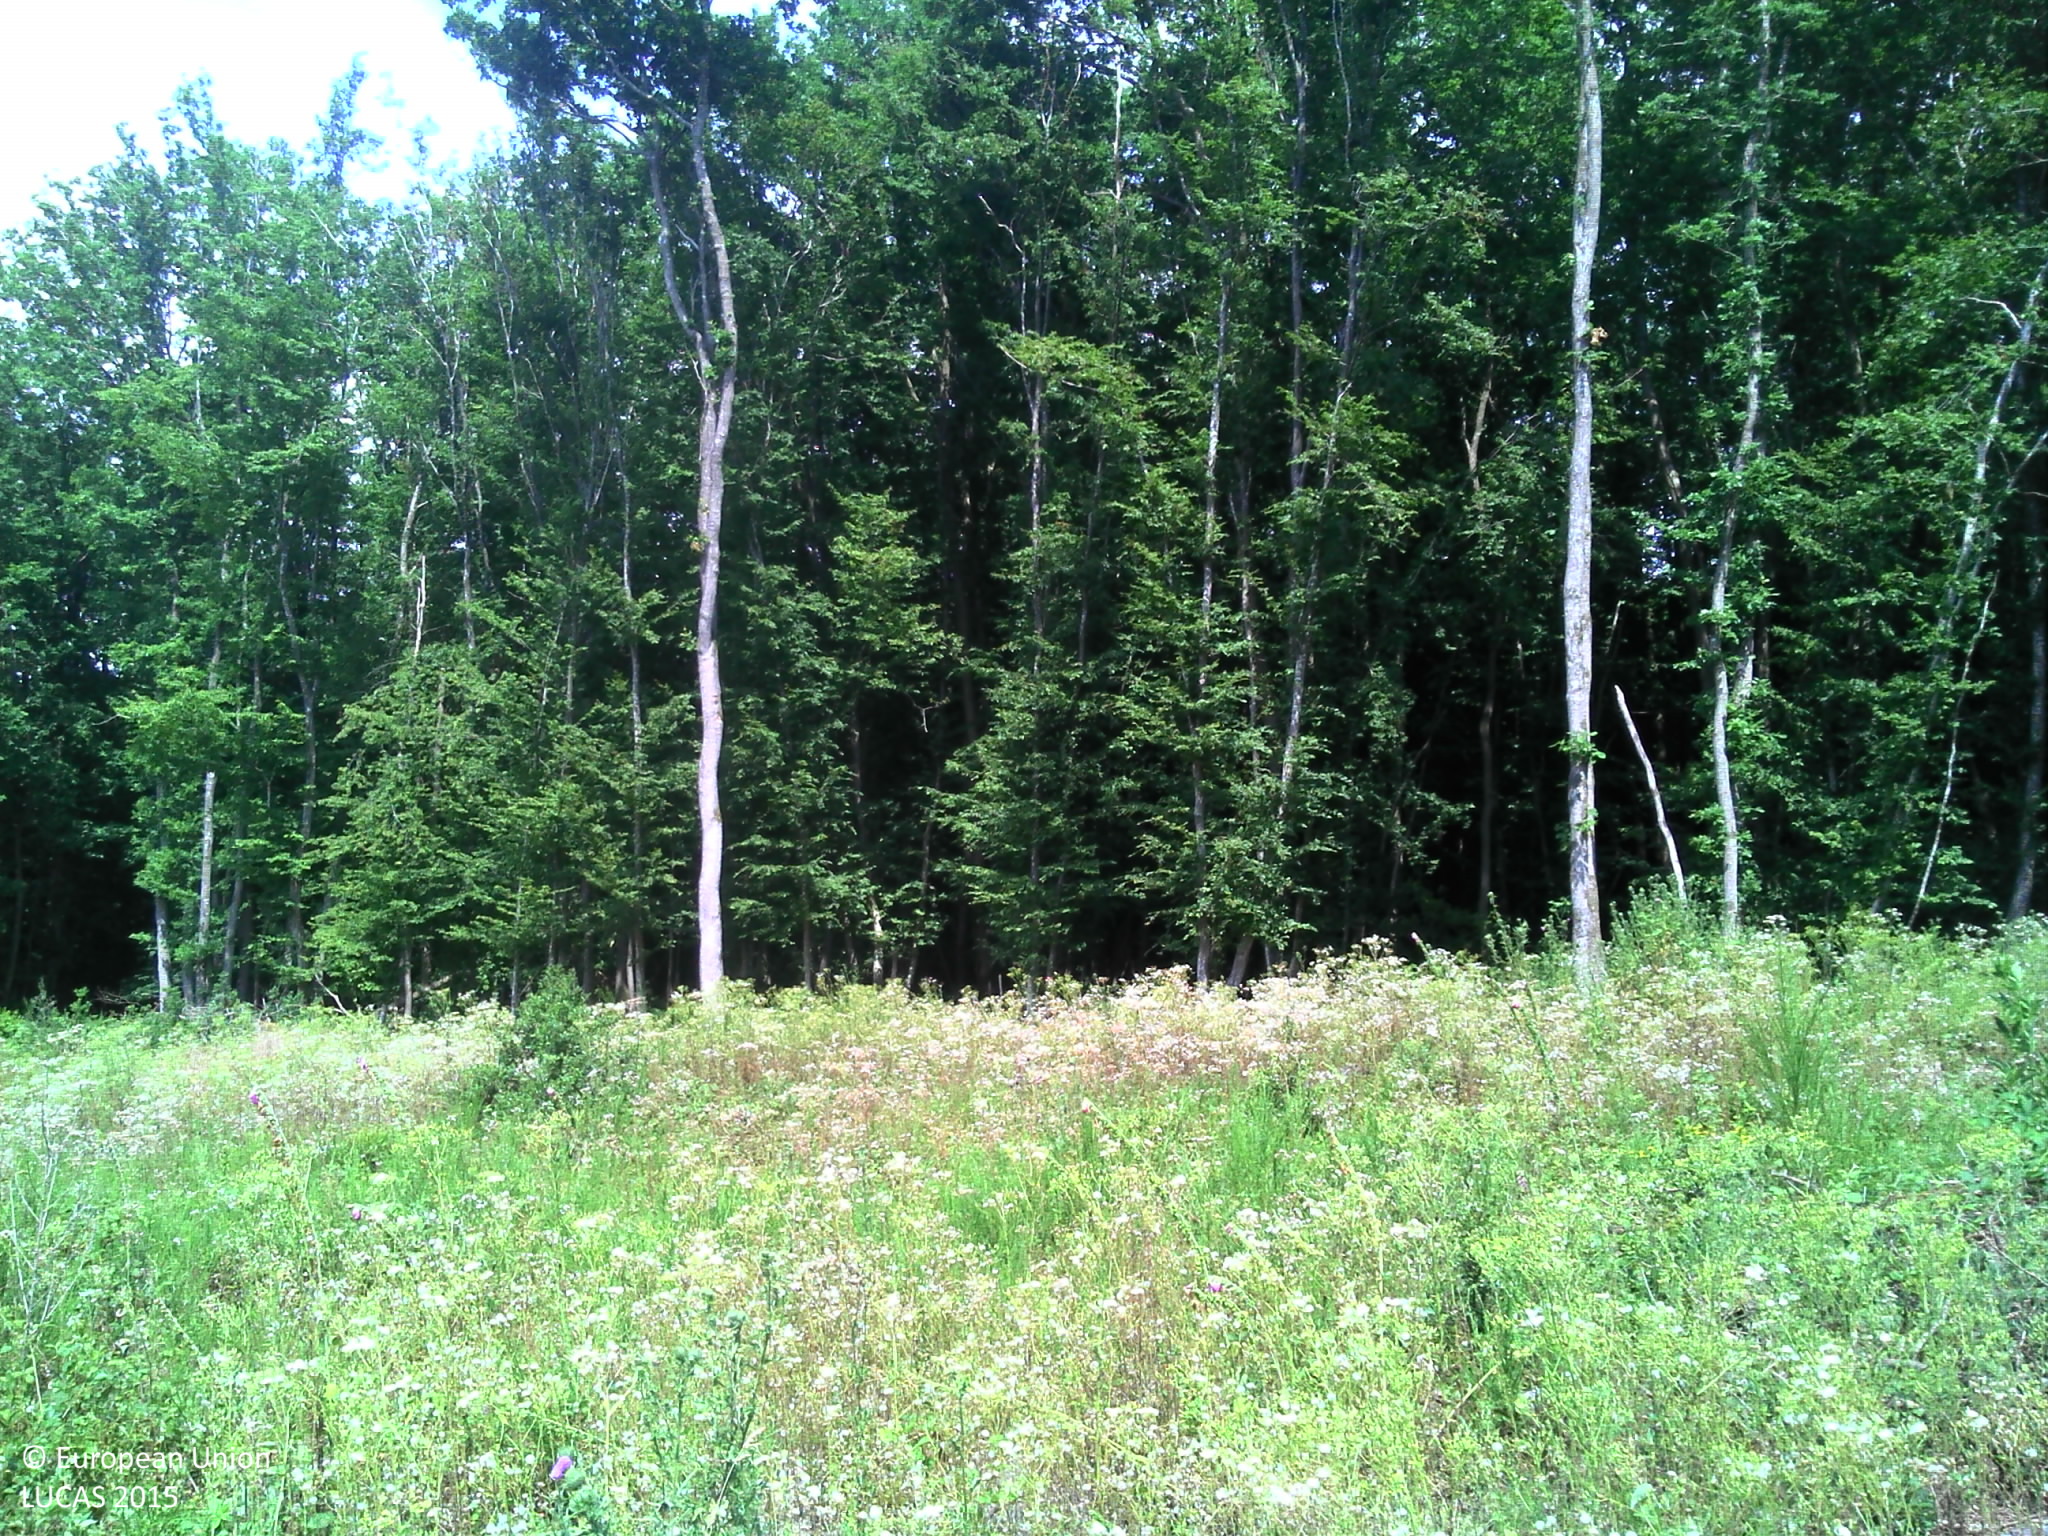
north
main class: Shrubland
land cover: Shrubland without tree cover
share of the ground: > 75 %
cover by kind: herbaceous plants 60 %, shrubs 40 %
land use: Forestry
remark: Clear cut
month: July
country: FR
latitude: 48.8119
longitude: 1.1970
